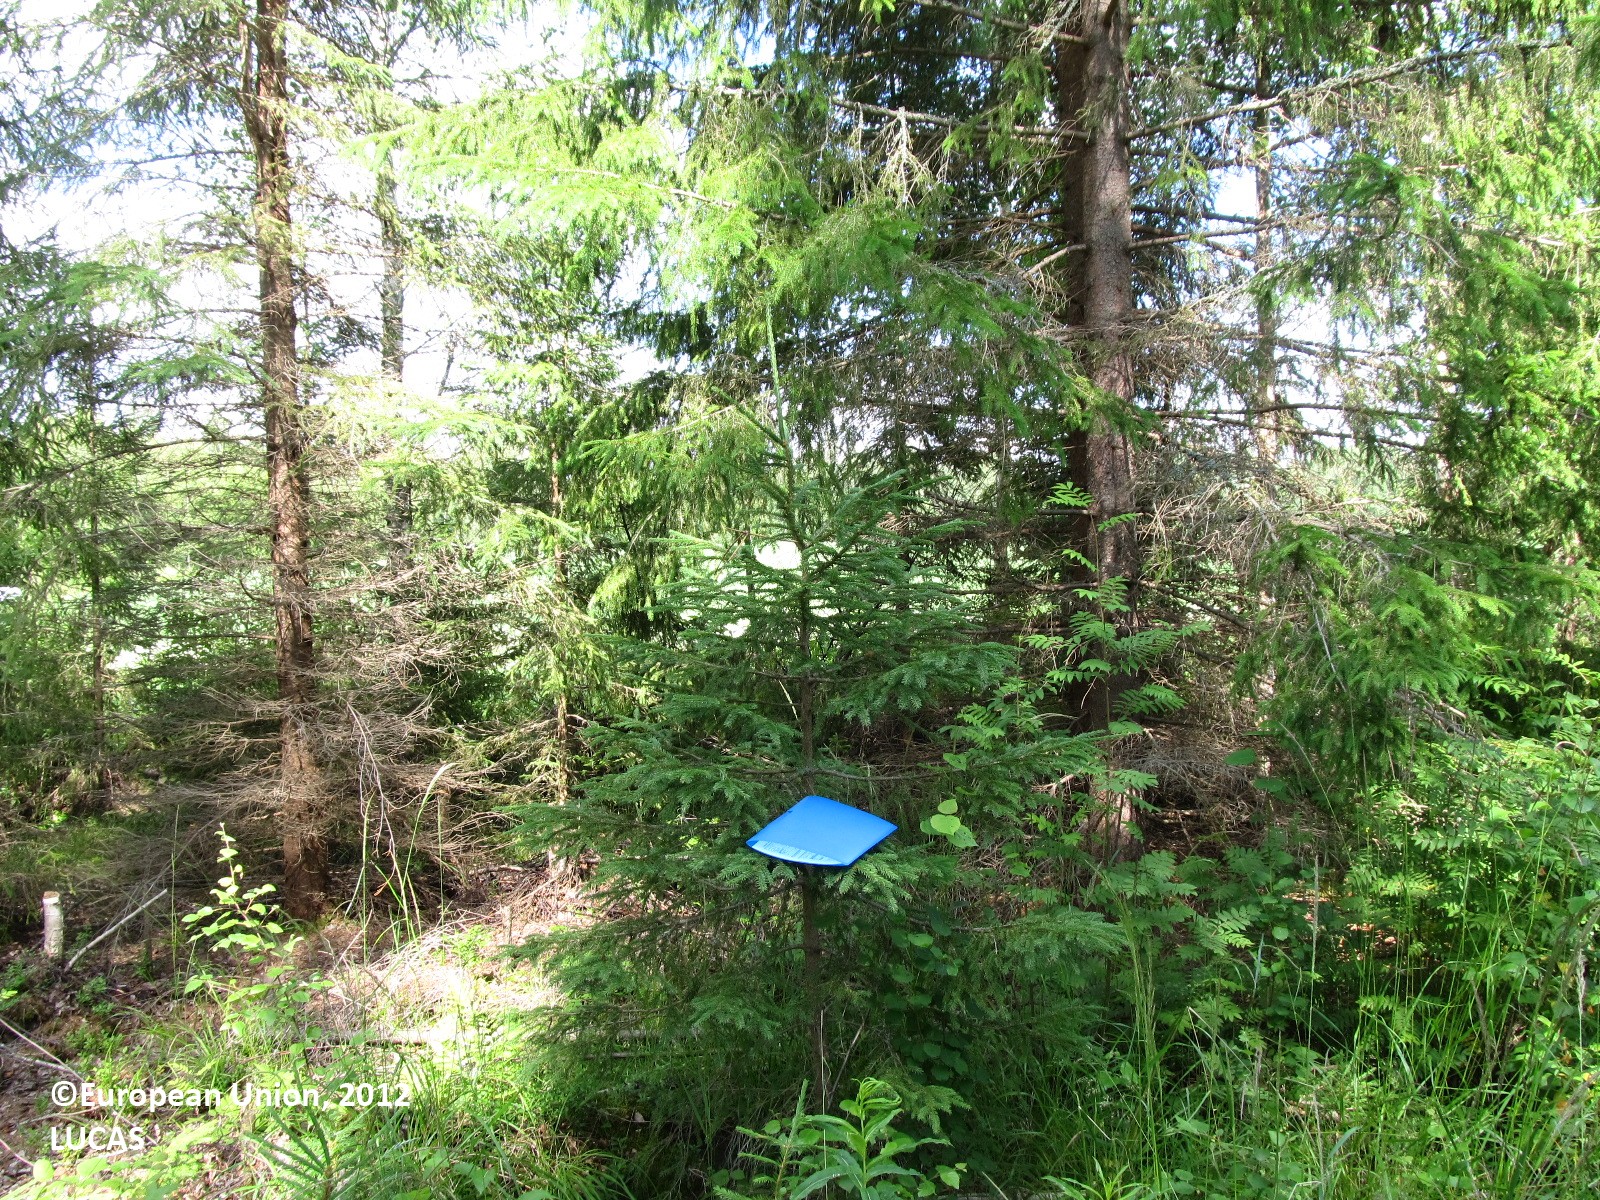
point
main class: Woodland
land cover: Spruce dominated mixed woodland
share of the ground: 25 - 50 %
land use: Forestry
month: July
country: FI
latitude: 61.9323
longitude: 28.3585
